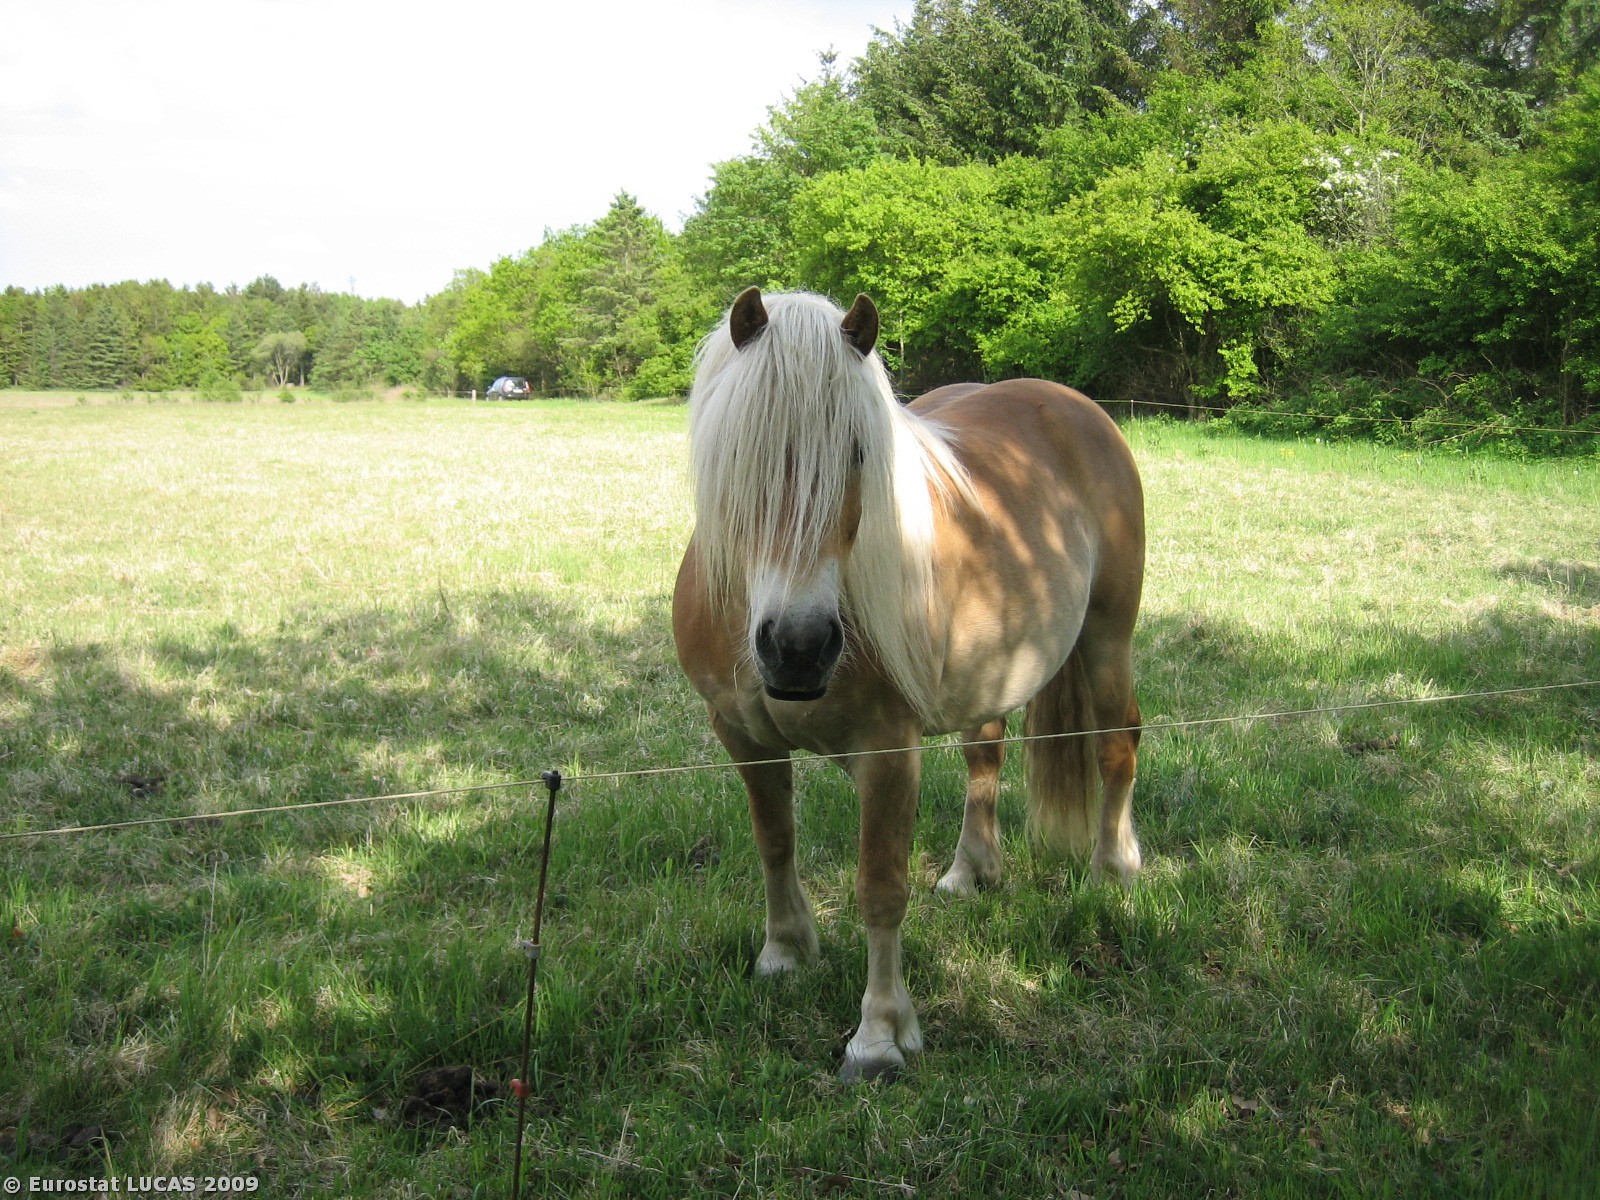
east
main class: Grassland
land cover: Grassland without tree/shrub cover
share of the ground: > 75 %
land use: Agriculture (excluding fallow land and kitchen gardens)
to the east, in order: Grassland without tree/shrub cover; Mixed woodland; Tracks; Coniferous woodland; Grassland without tree/shrub cover; Coniferous woodland
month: May
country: DK
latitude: 56.1859
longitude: 9.3080
